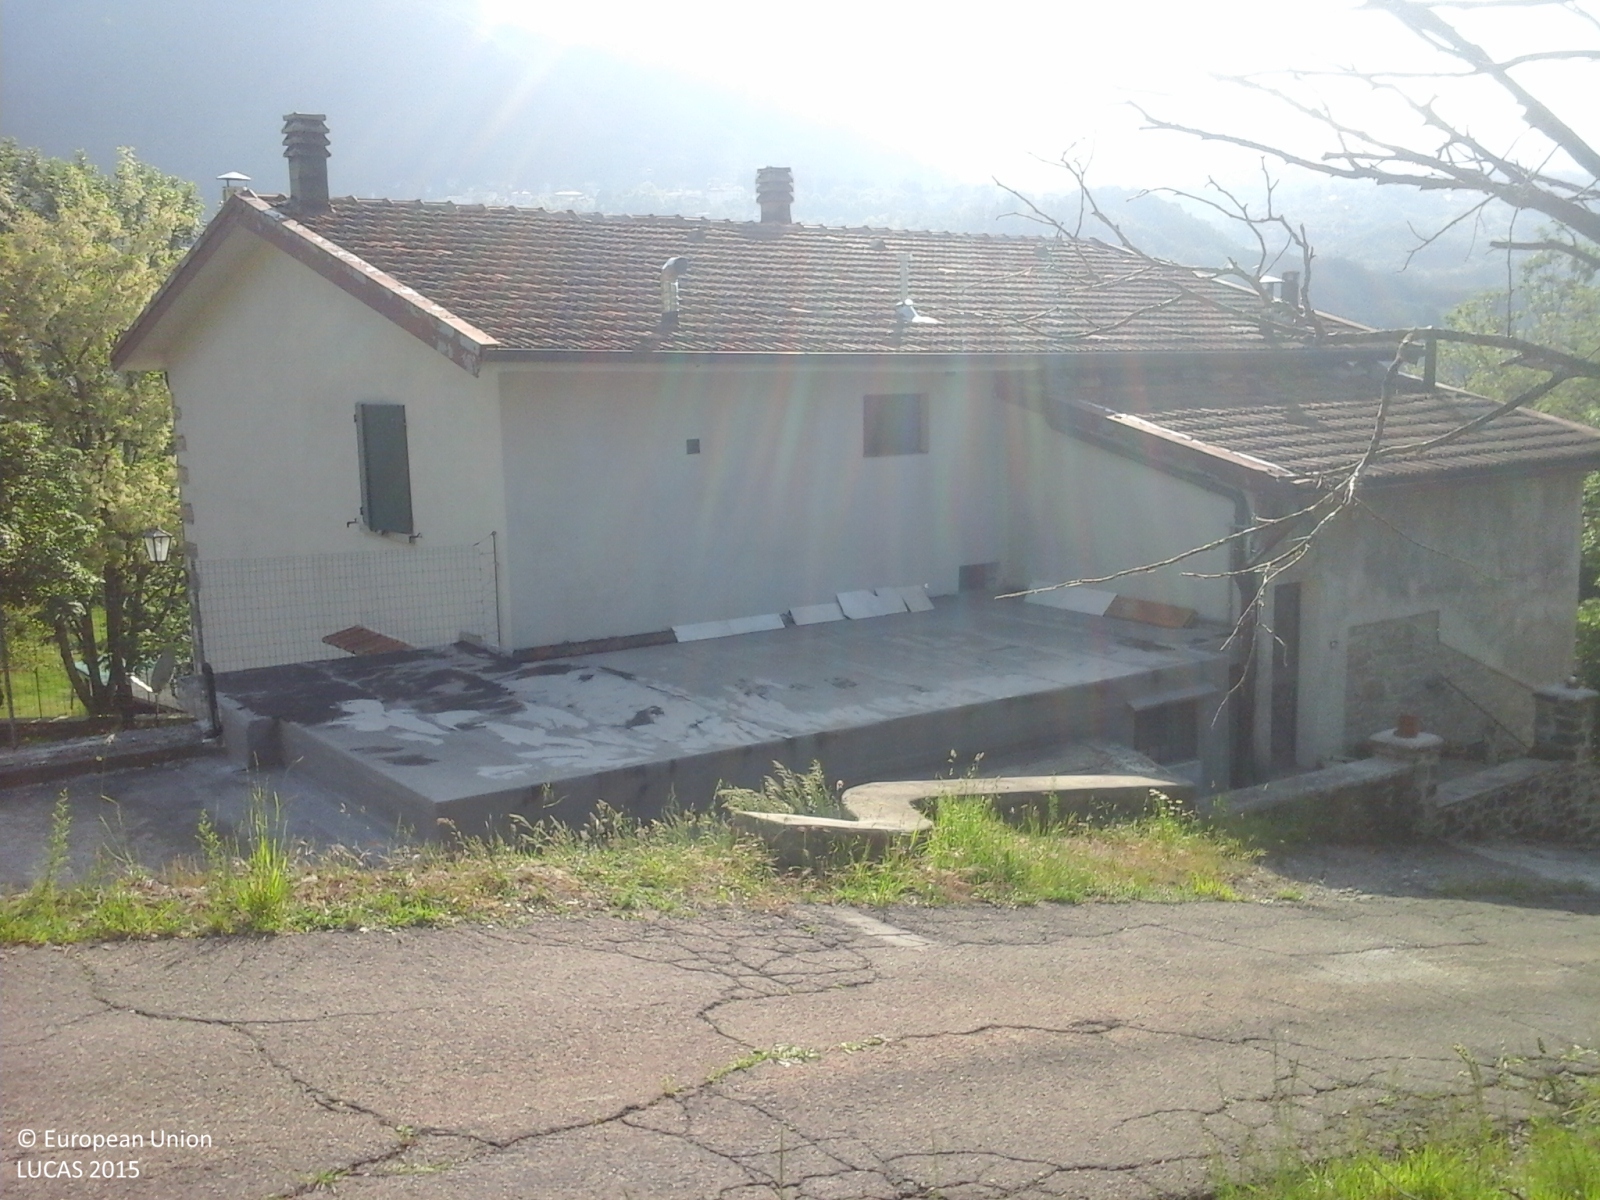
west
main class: Woodland
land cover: Broadleaved woodland
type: mesophytic deciduous forest
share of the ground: > 75 %
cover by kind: broadleaved forest trees 100 %
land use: Forestry
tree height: > 5 m
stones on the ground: 10 - 25 %
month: May
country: IT
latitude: 44.1662
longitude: 10.9107
